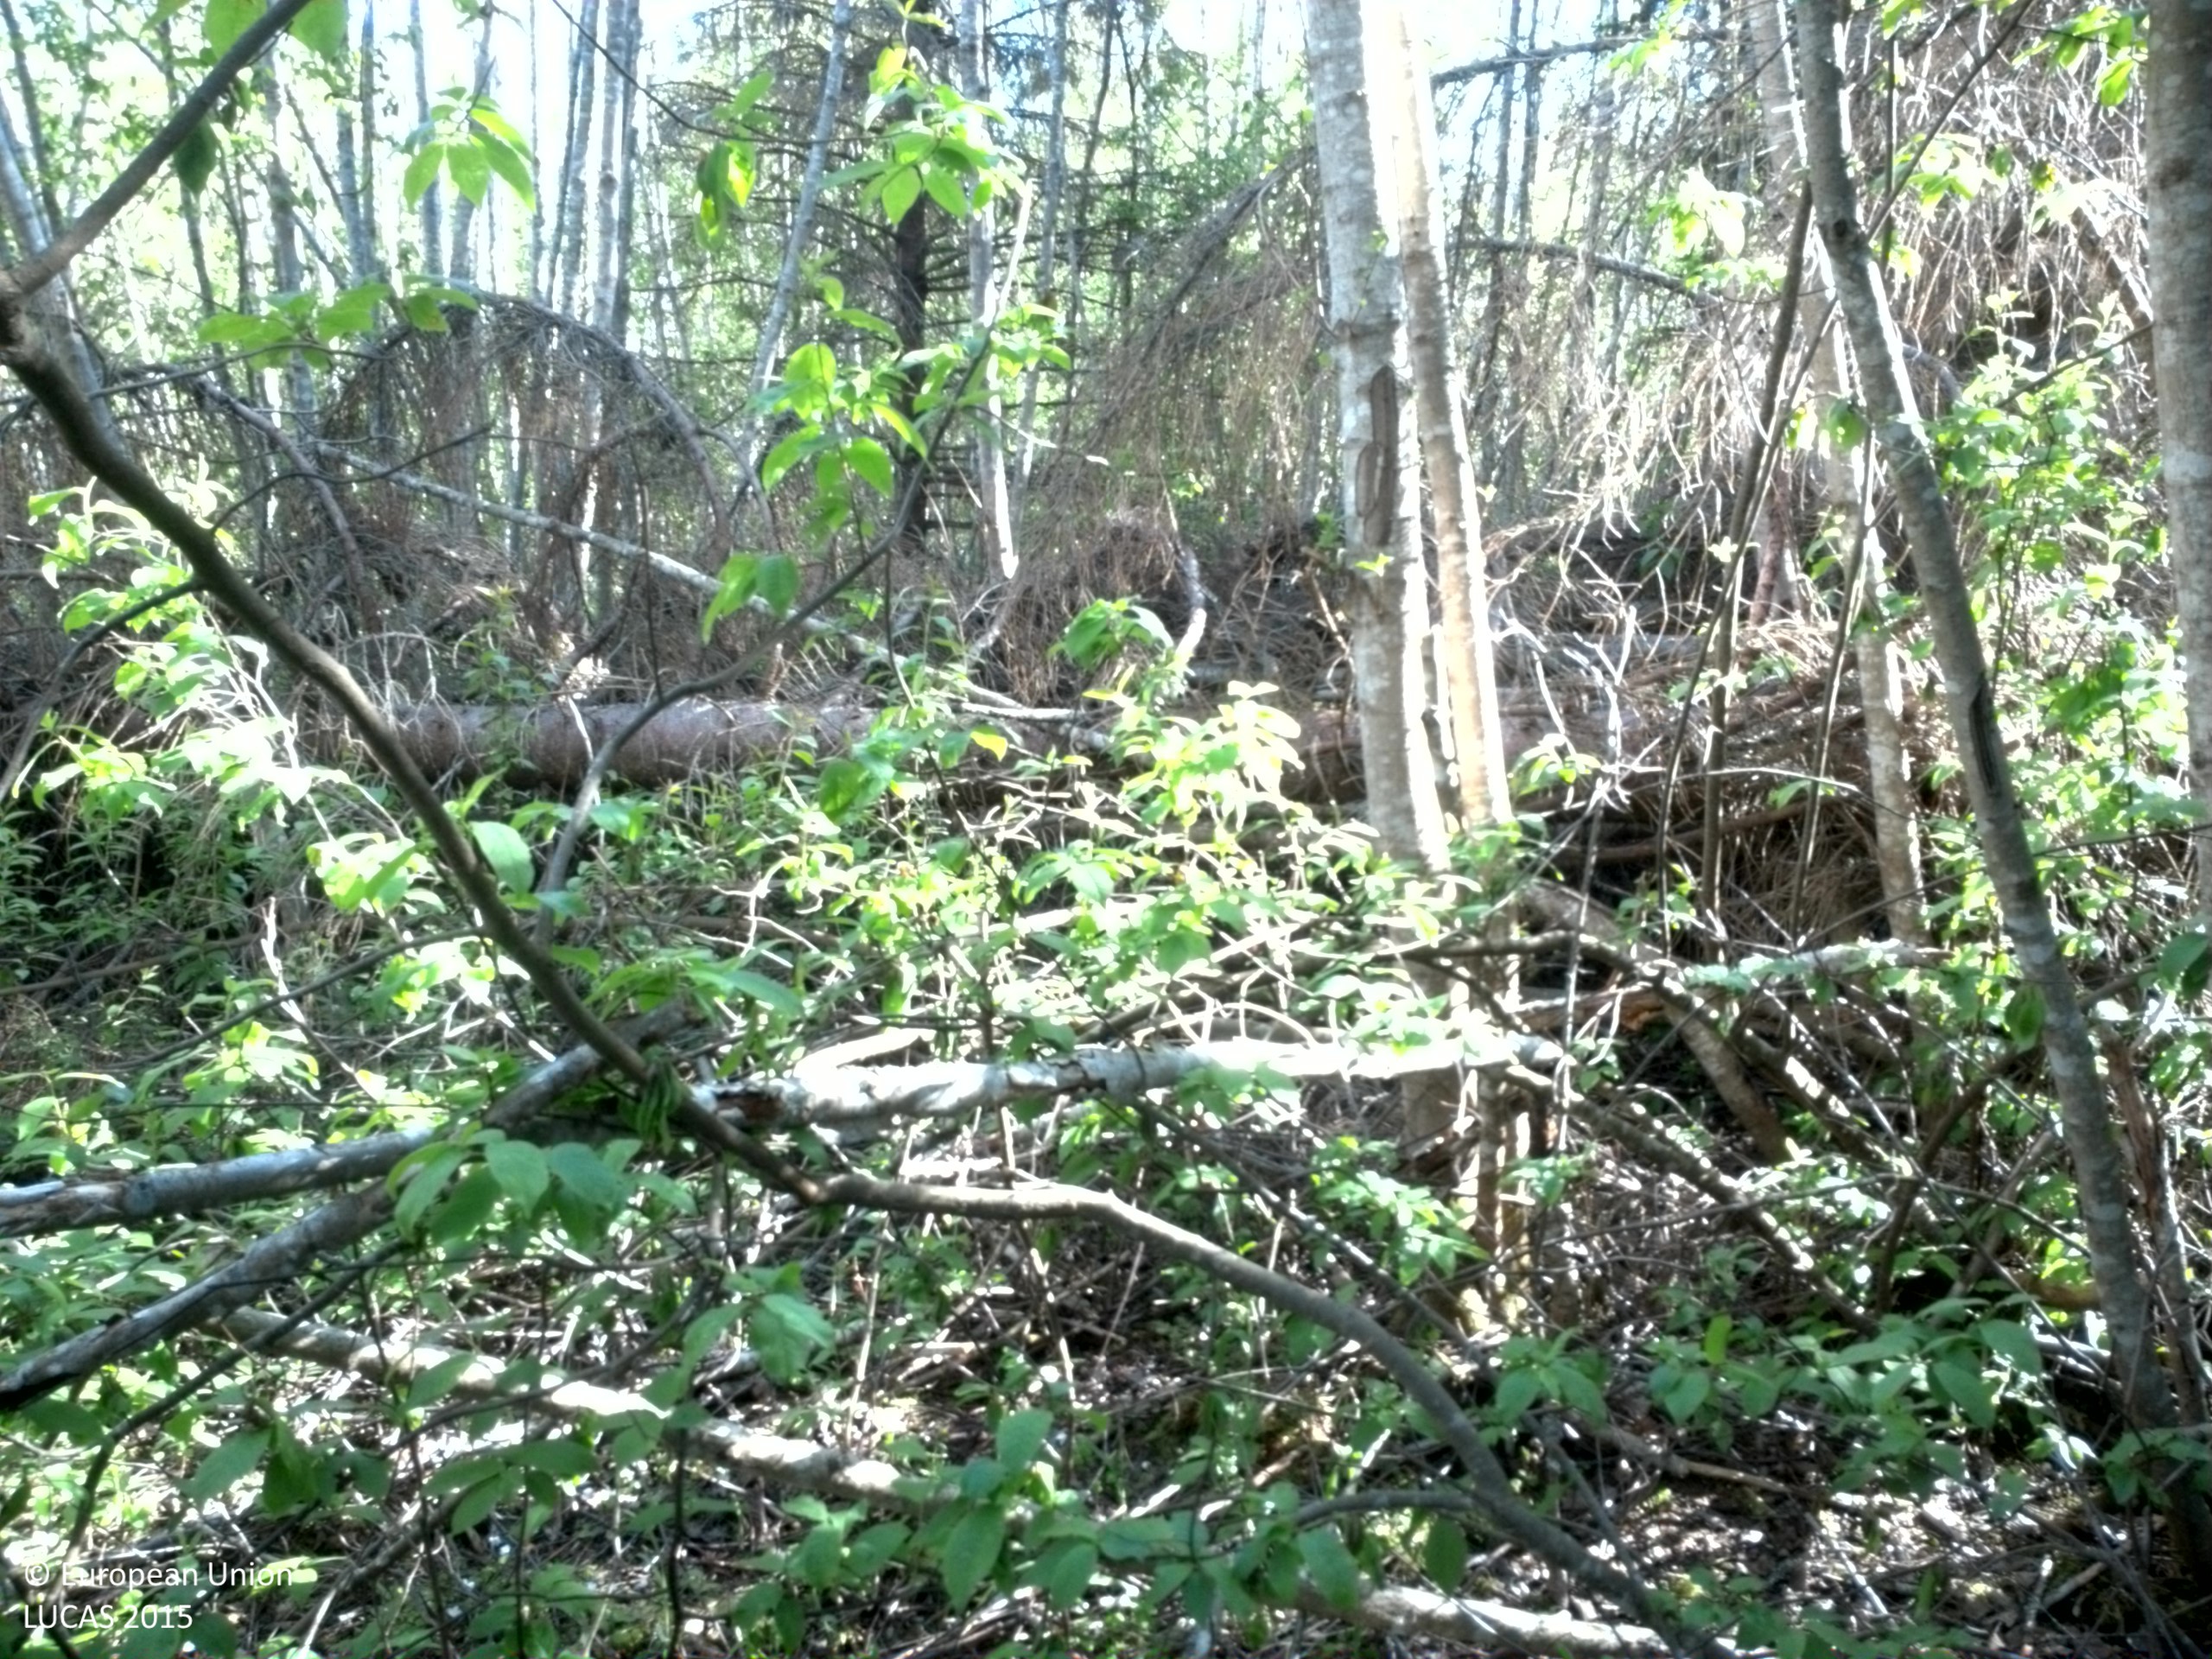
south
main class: Woodland
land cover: Broadleaved woodland
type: hemiboreal forest and nemoral coniferous forest and mixed broadleaved-coniferous forest
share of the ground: > 75 %
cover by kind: broadleaved forest trees 80 %, coniferous forest trees 10 %, herbaceous plants 10 %
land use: Forestry
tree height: > 5 m
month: May
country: SE
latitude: 63.0791
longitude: 17.8367
